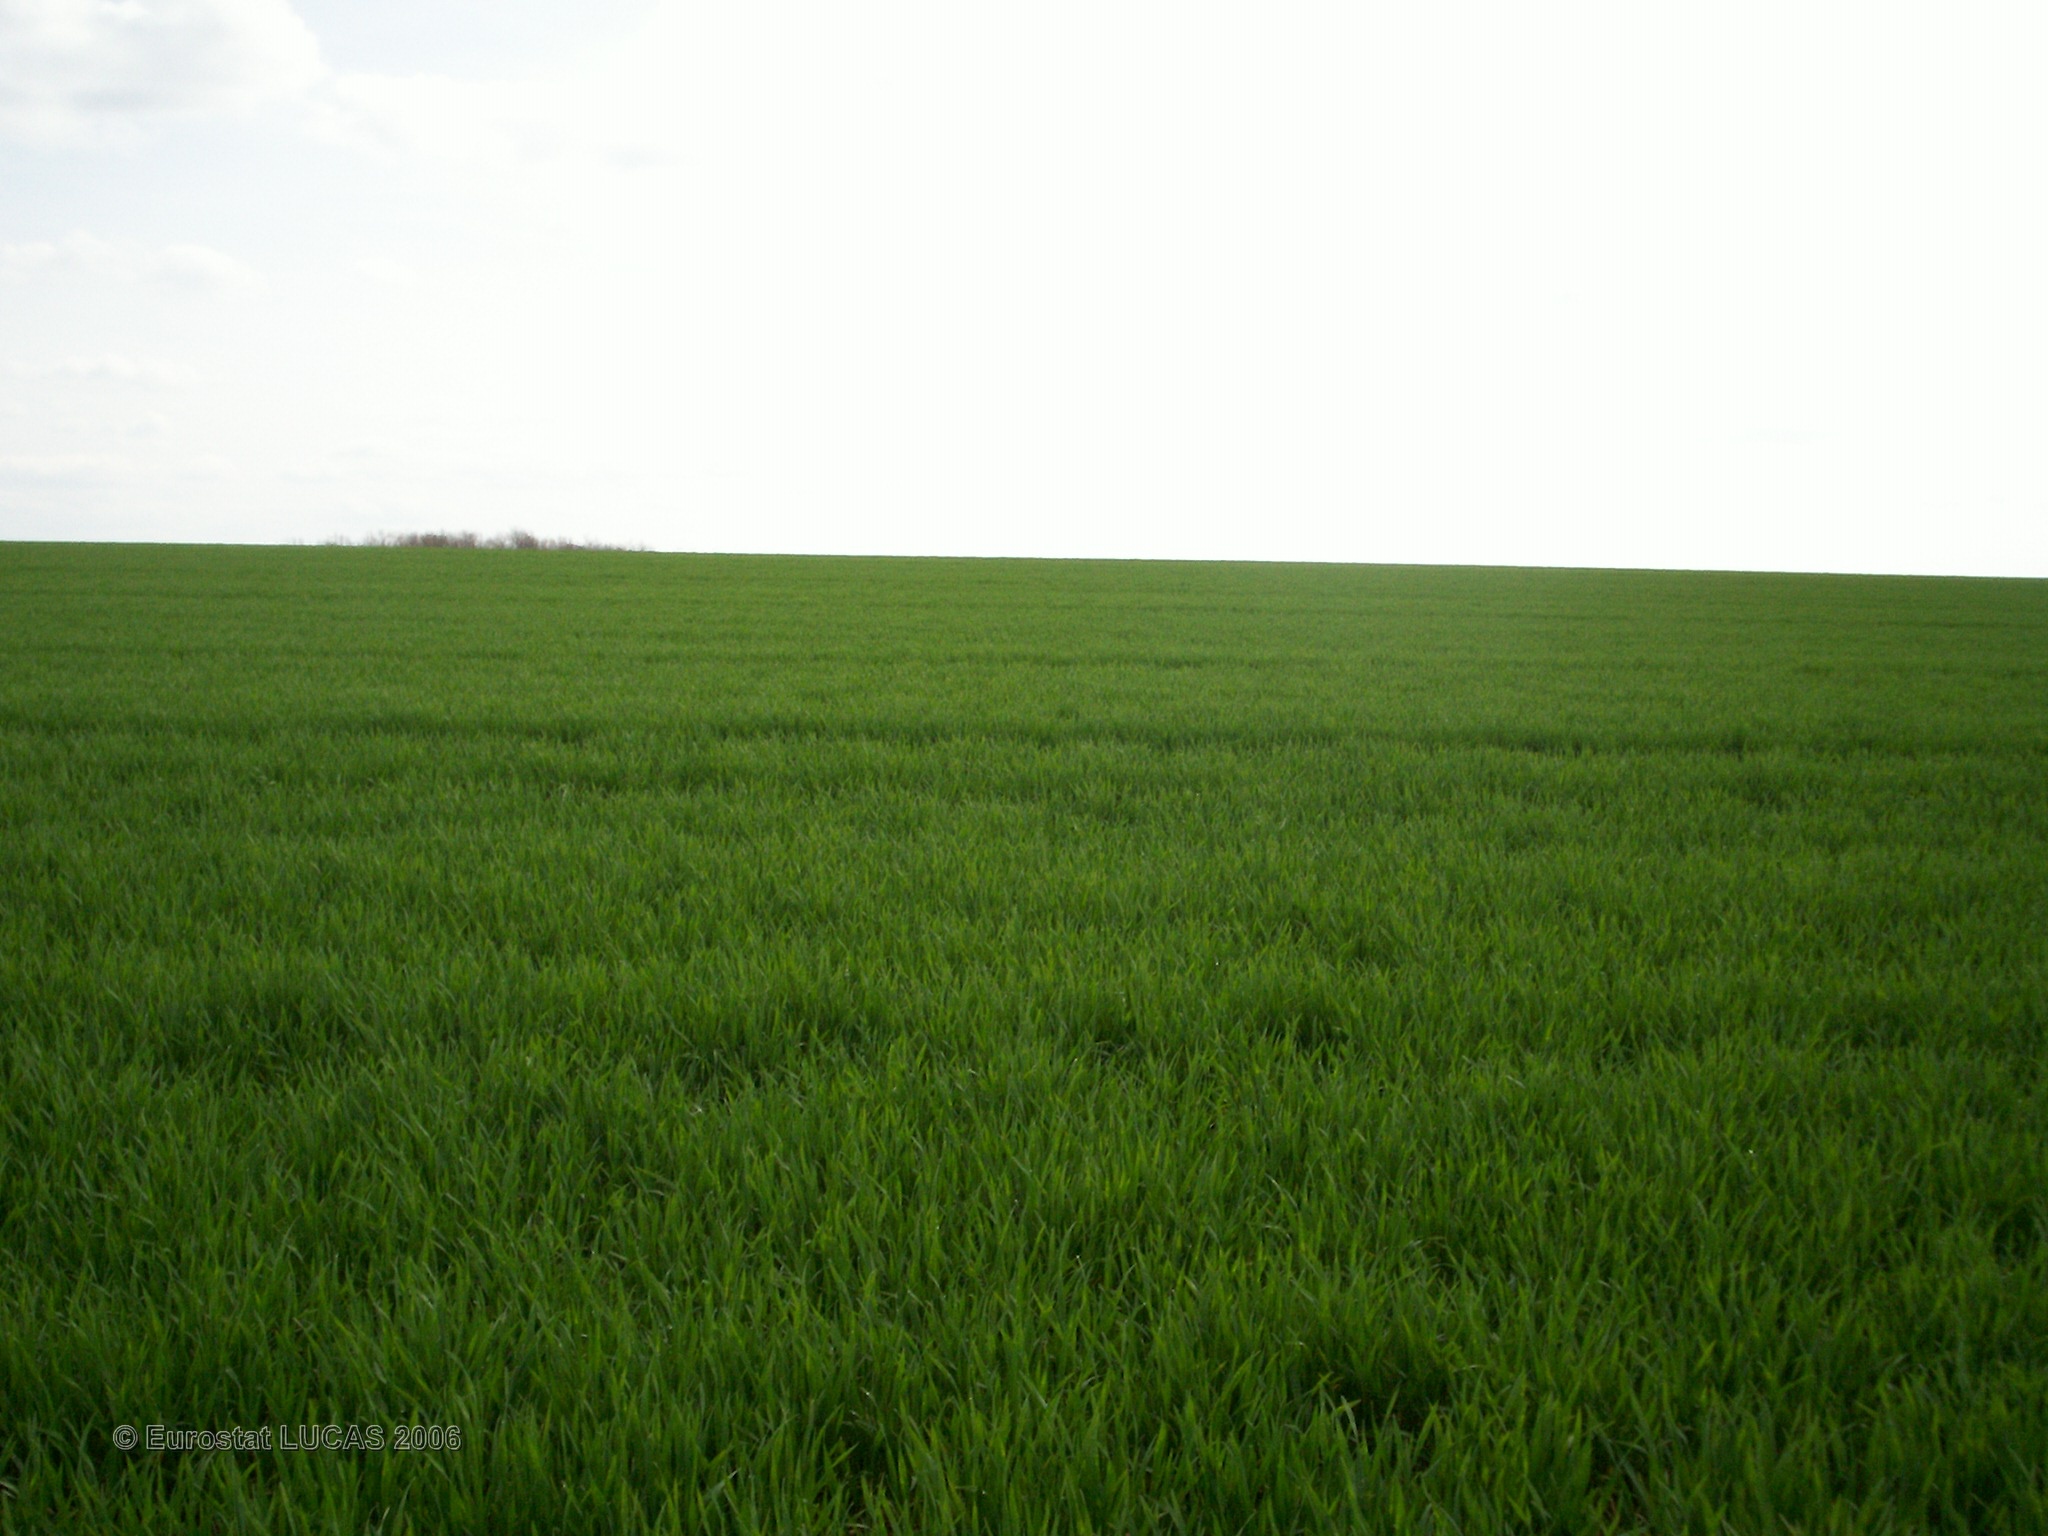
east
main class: Cropland
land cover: Common wheat
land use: Agriculture (excluding fallow land and kitchen gardens)
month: April
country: FR
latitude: 47.9181
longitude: 4.0422
